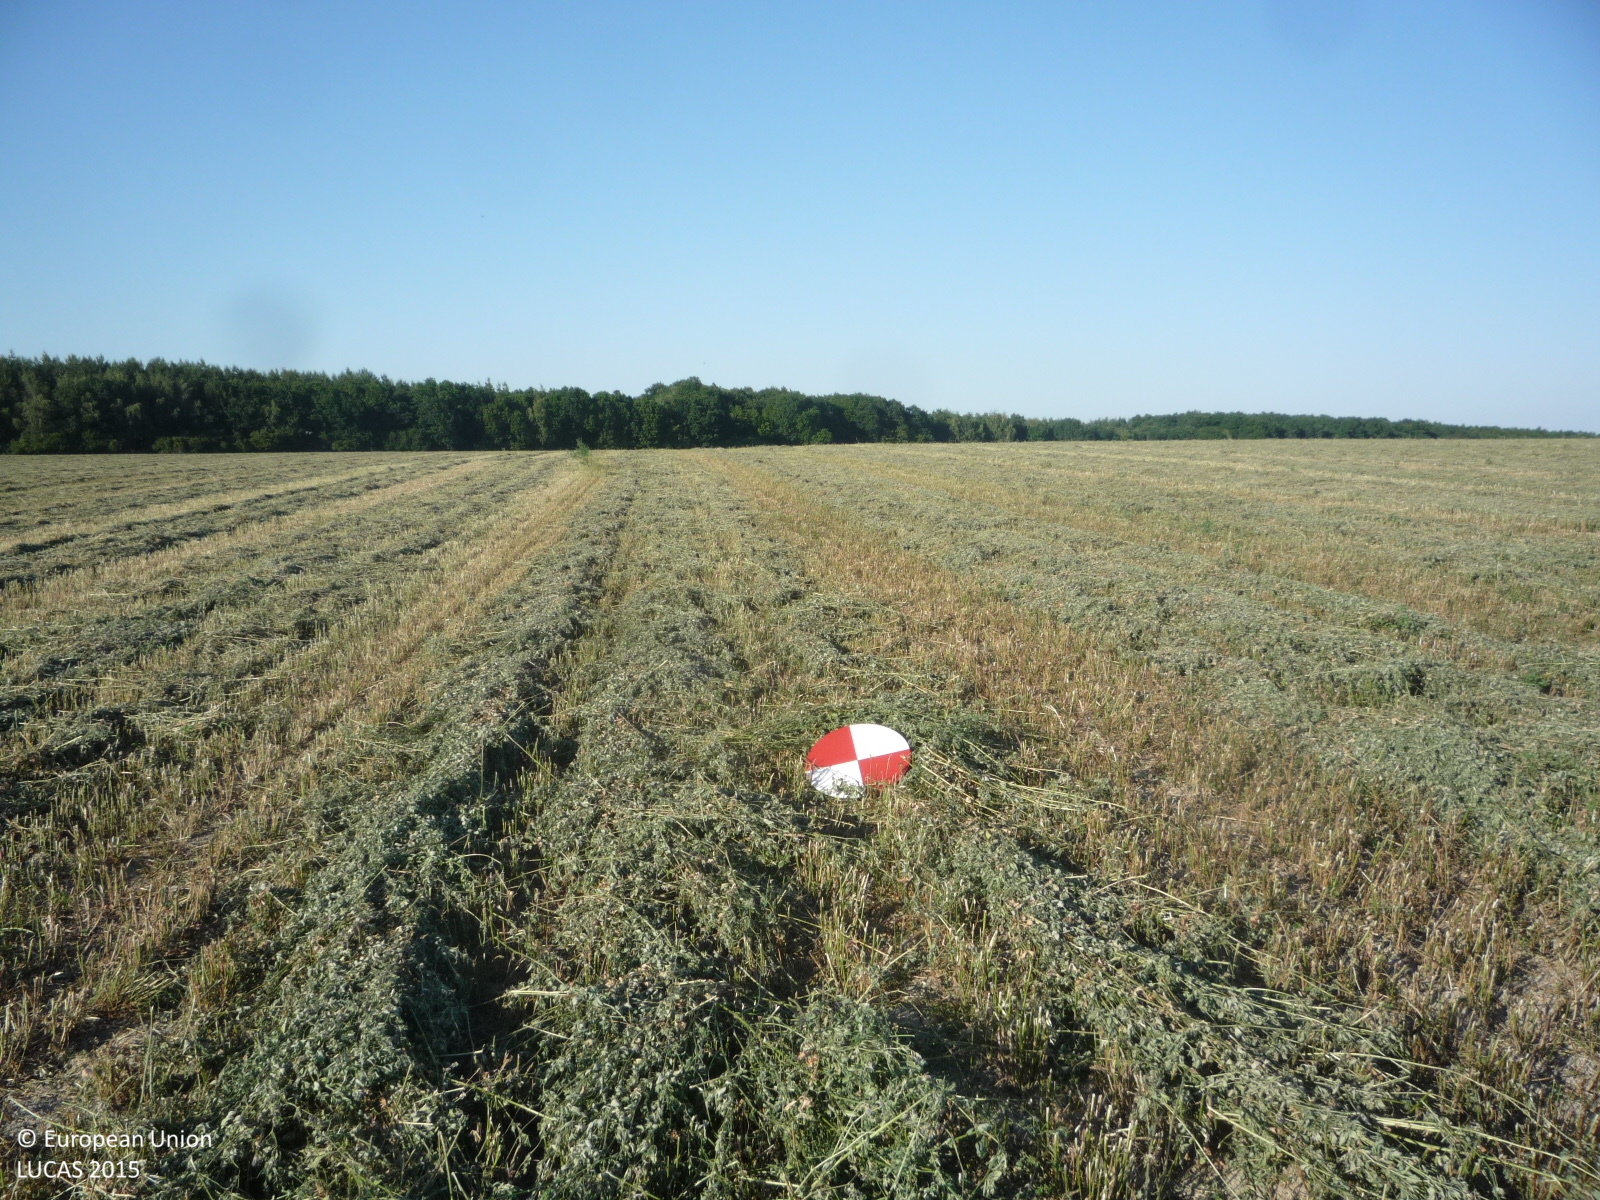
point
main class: Cropland
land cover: Lucerne
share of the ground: > 75 %
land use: Agriculture (excluding fallow land and kitchen gardens)
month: July
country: CZ
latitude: 50.2071
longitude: 15.2578
